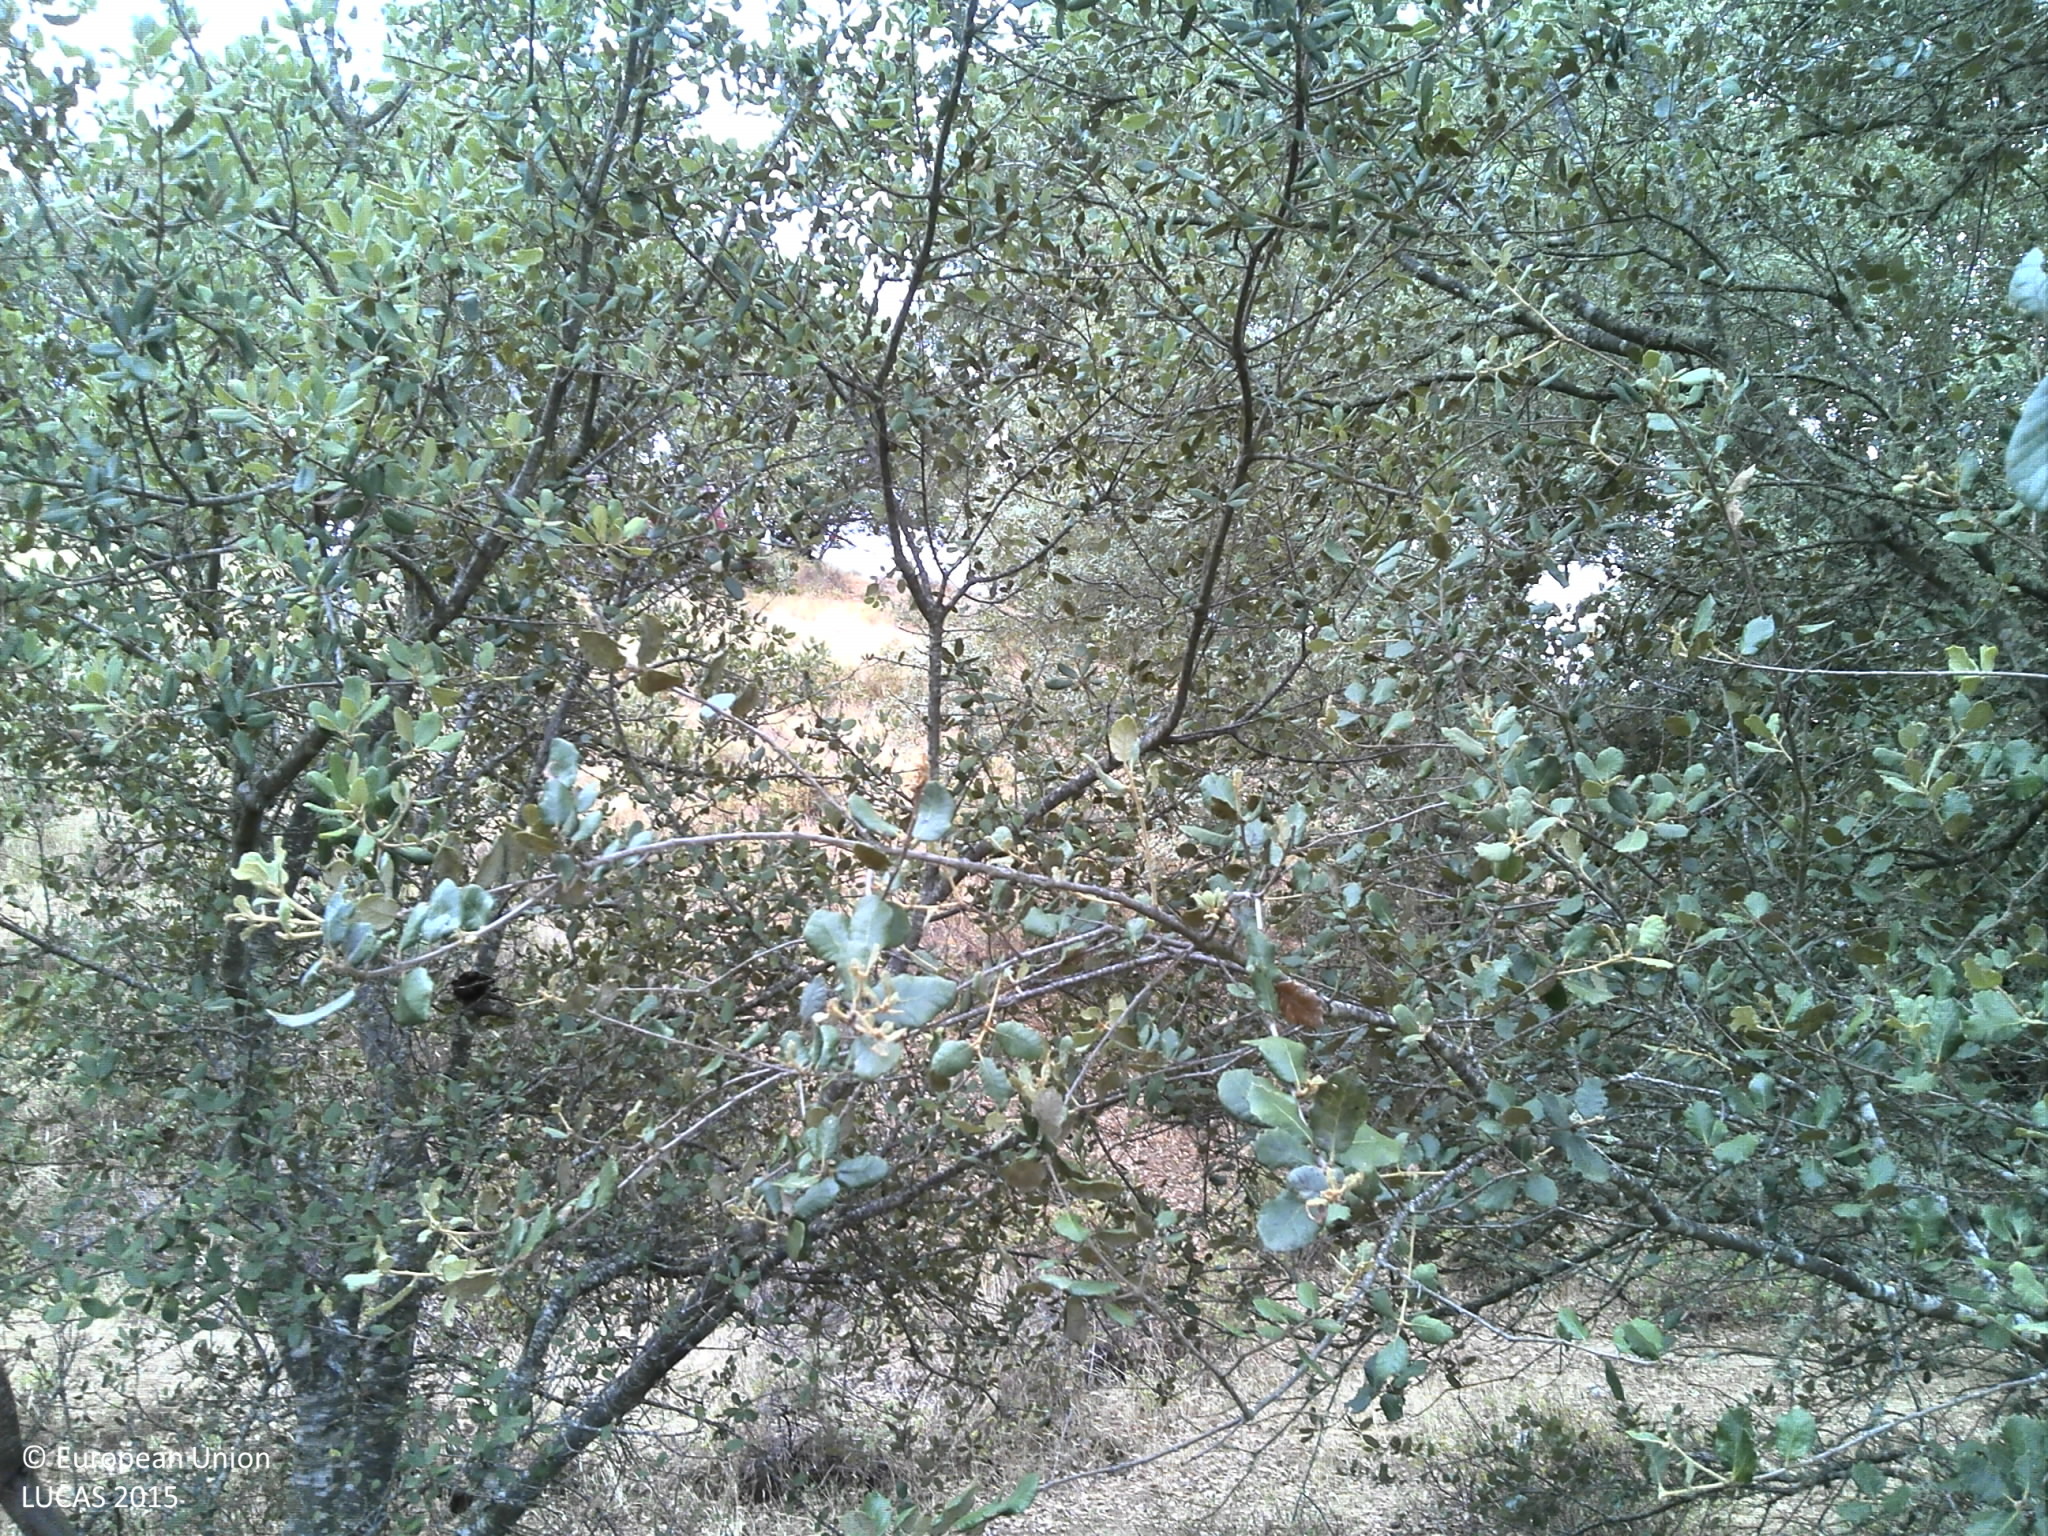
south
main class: Woodland
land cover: Broadleaved woodland
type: broadleaved evergreen forest
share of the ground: 25 - 50 %
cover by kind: broadleaved forest trees 50 %, shrubs 20 %, herbaceous plants 20 %, unconsolidated bare surface 10 %
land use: Forestry
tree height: > 5 m
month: June
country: PT
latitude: 38.6754
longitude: -7.7269
